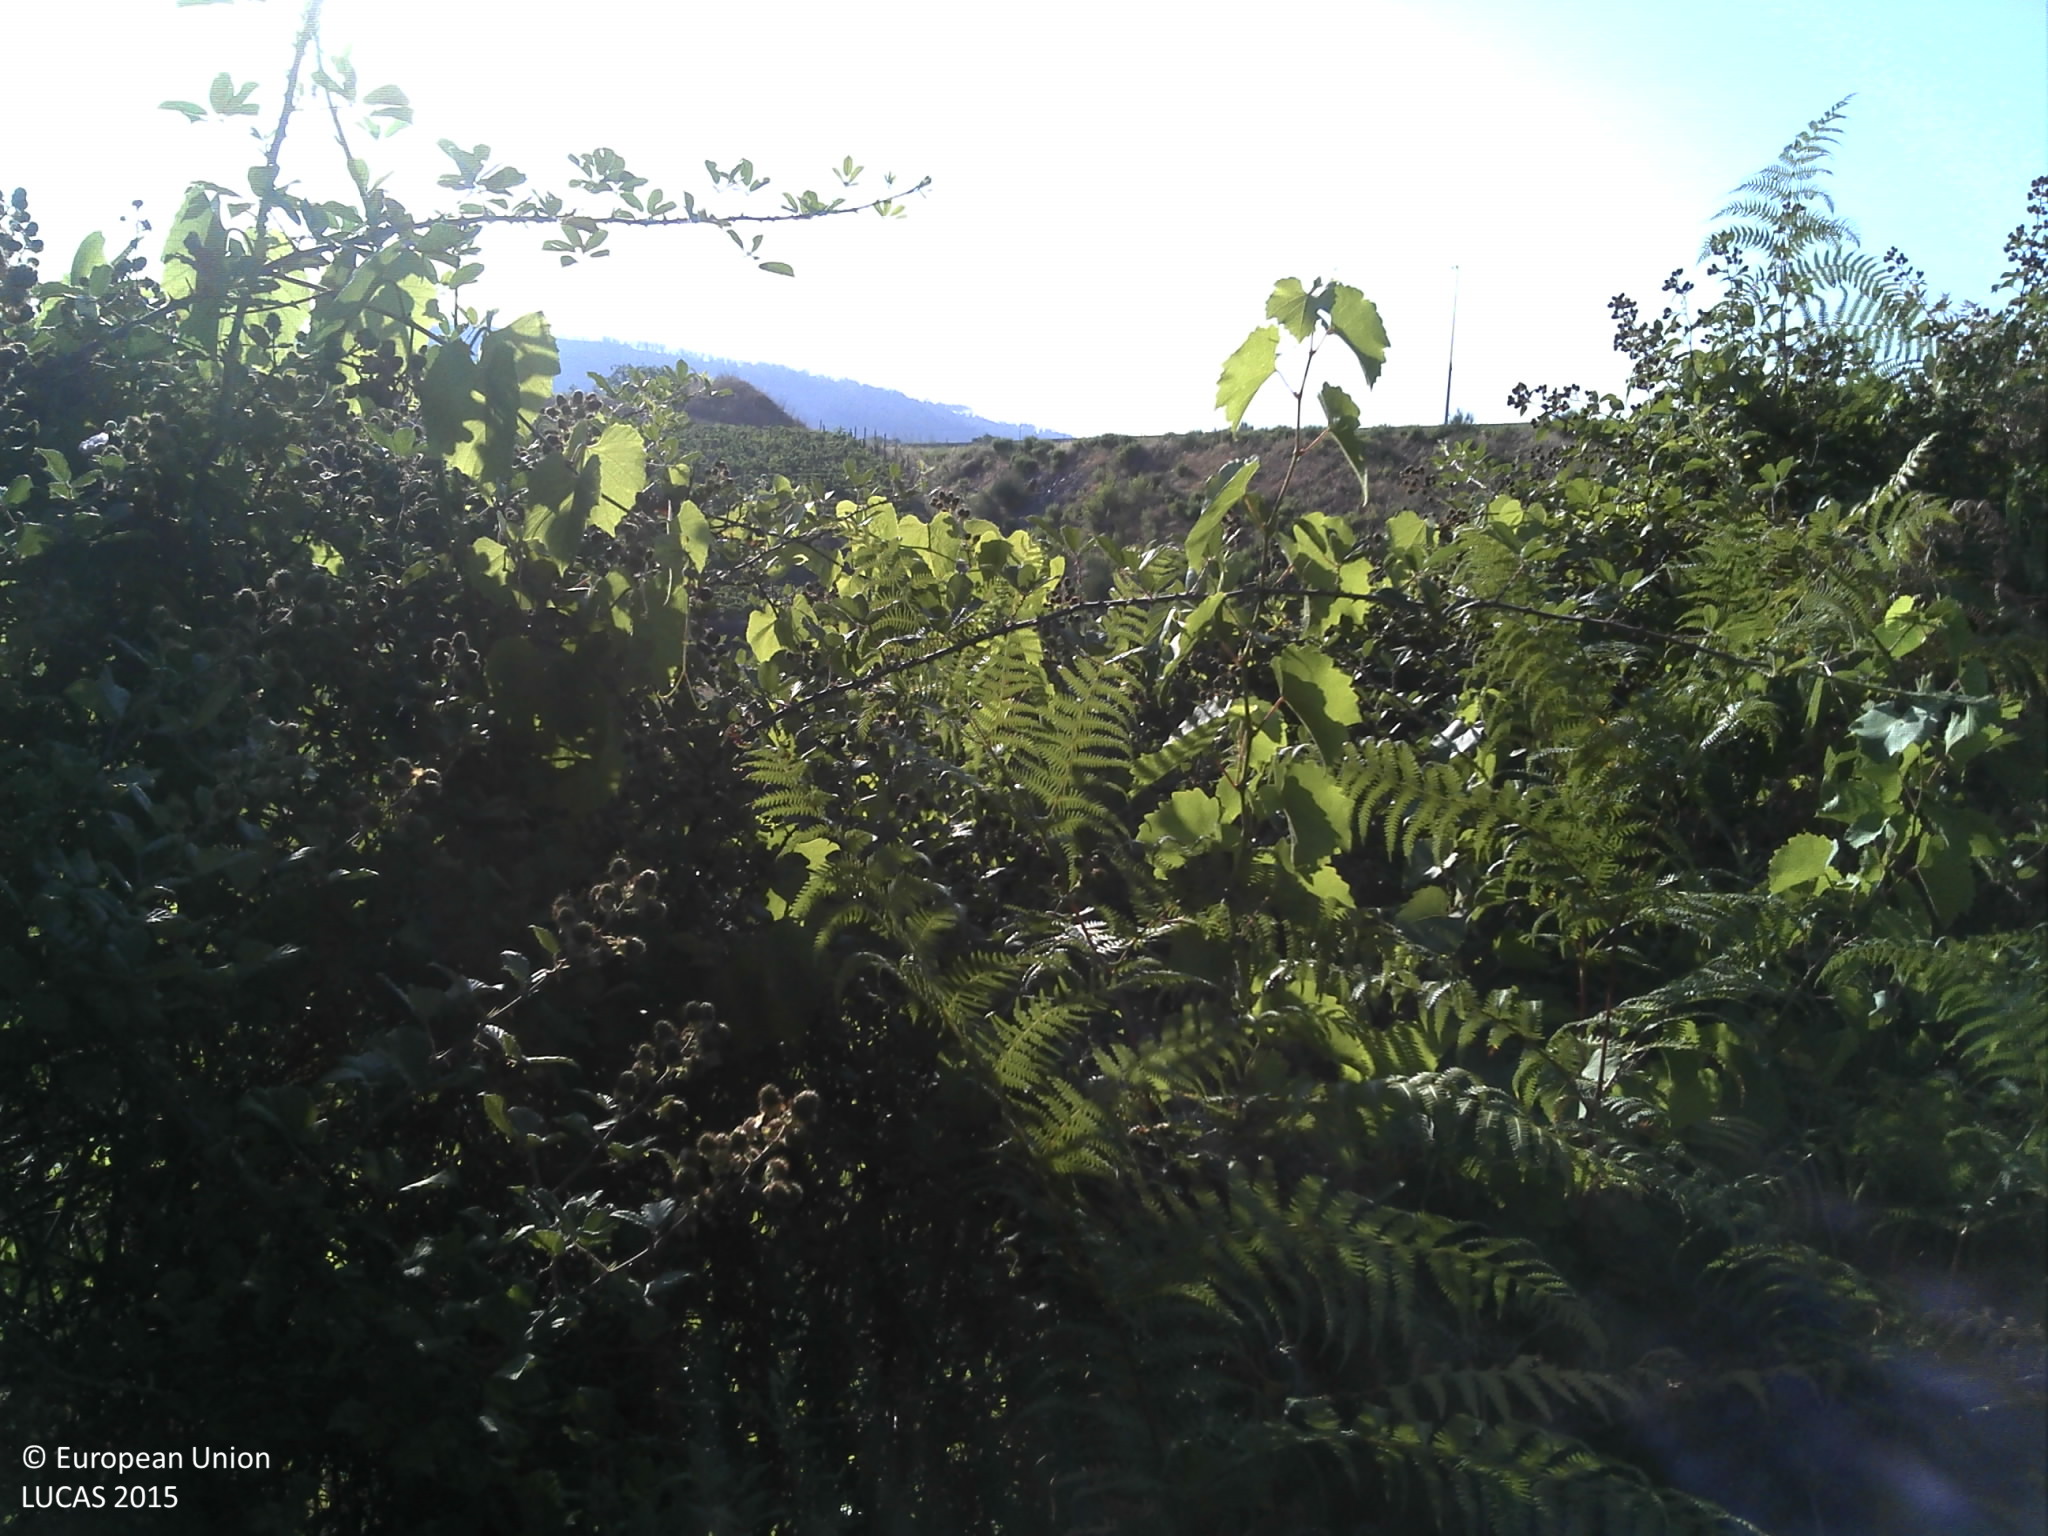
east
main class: Shrubland
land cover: Shrubland with sparse tree cover
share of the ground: > 75 %
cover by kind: shrubs 90 %, coniferous forest trees 5 %, herbaceous plants 5 %
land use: Abandoned areas
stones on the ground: 25 - 50 %
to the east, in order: Shrubland with sparse tree cover; Dry stone walls; Shrubland without tree cover; Dry stone walls; Ditches and canals; Grassland with sparse tree/shrub cover; Dry stone walls; Vineyards; Shrubland without tree cover; Vineyards; Olive groves; Fences; Grassland without tree/shrub cover; Paved roads, cycling and walking lanes
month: July
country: PT
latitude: 41.4049
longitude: -7.4330
